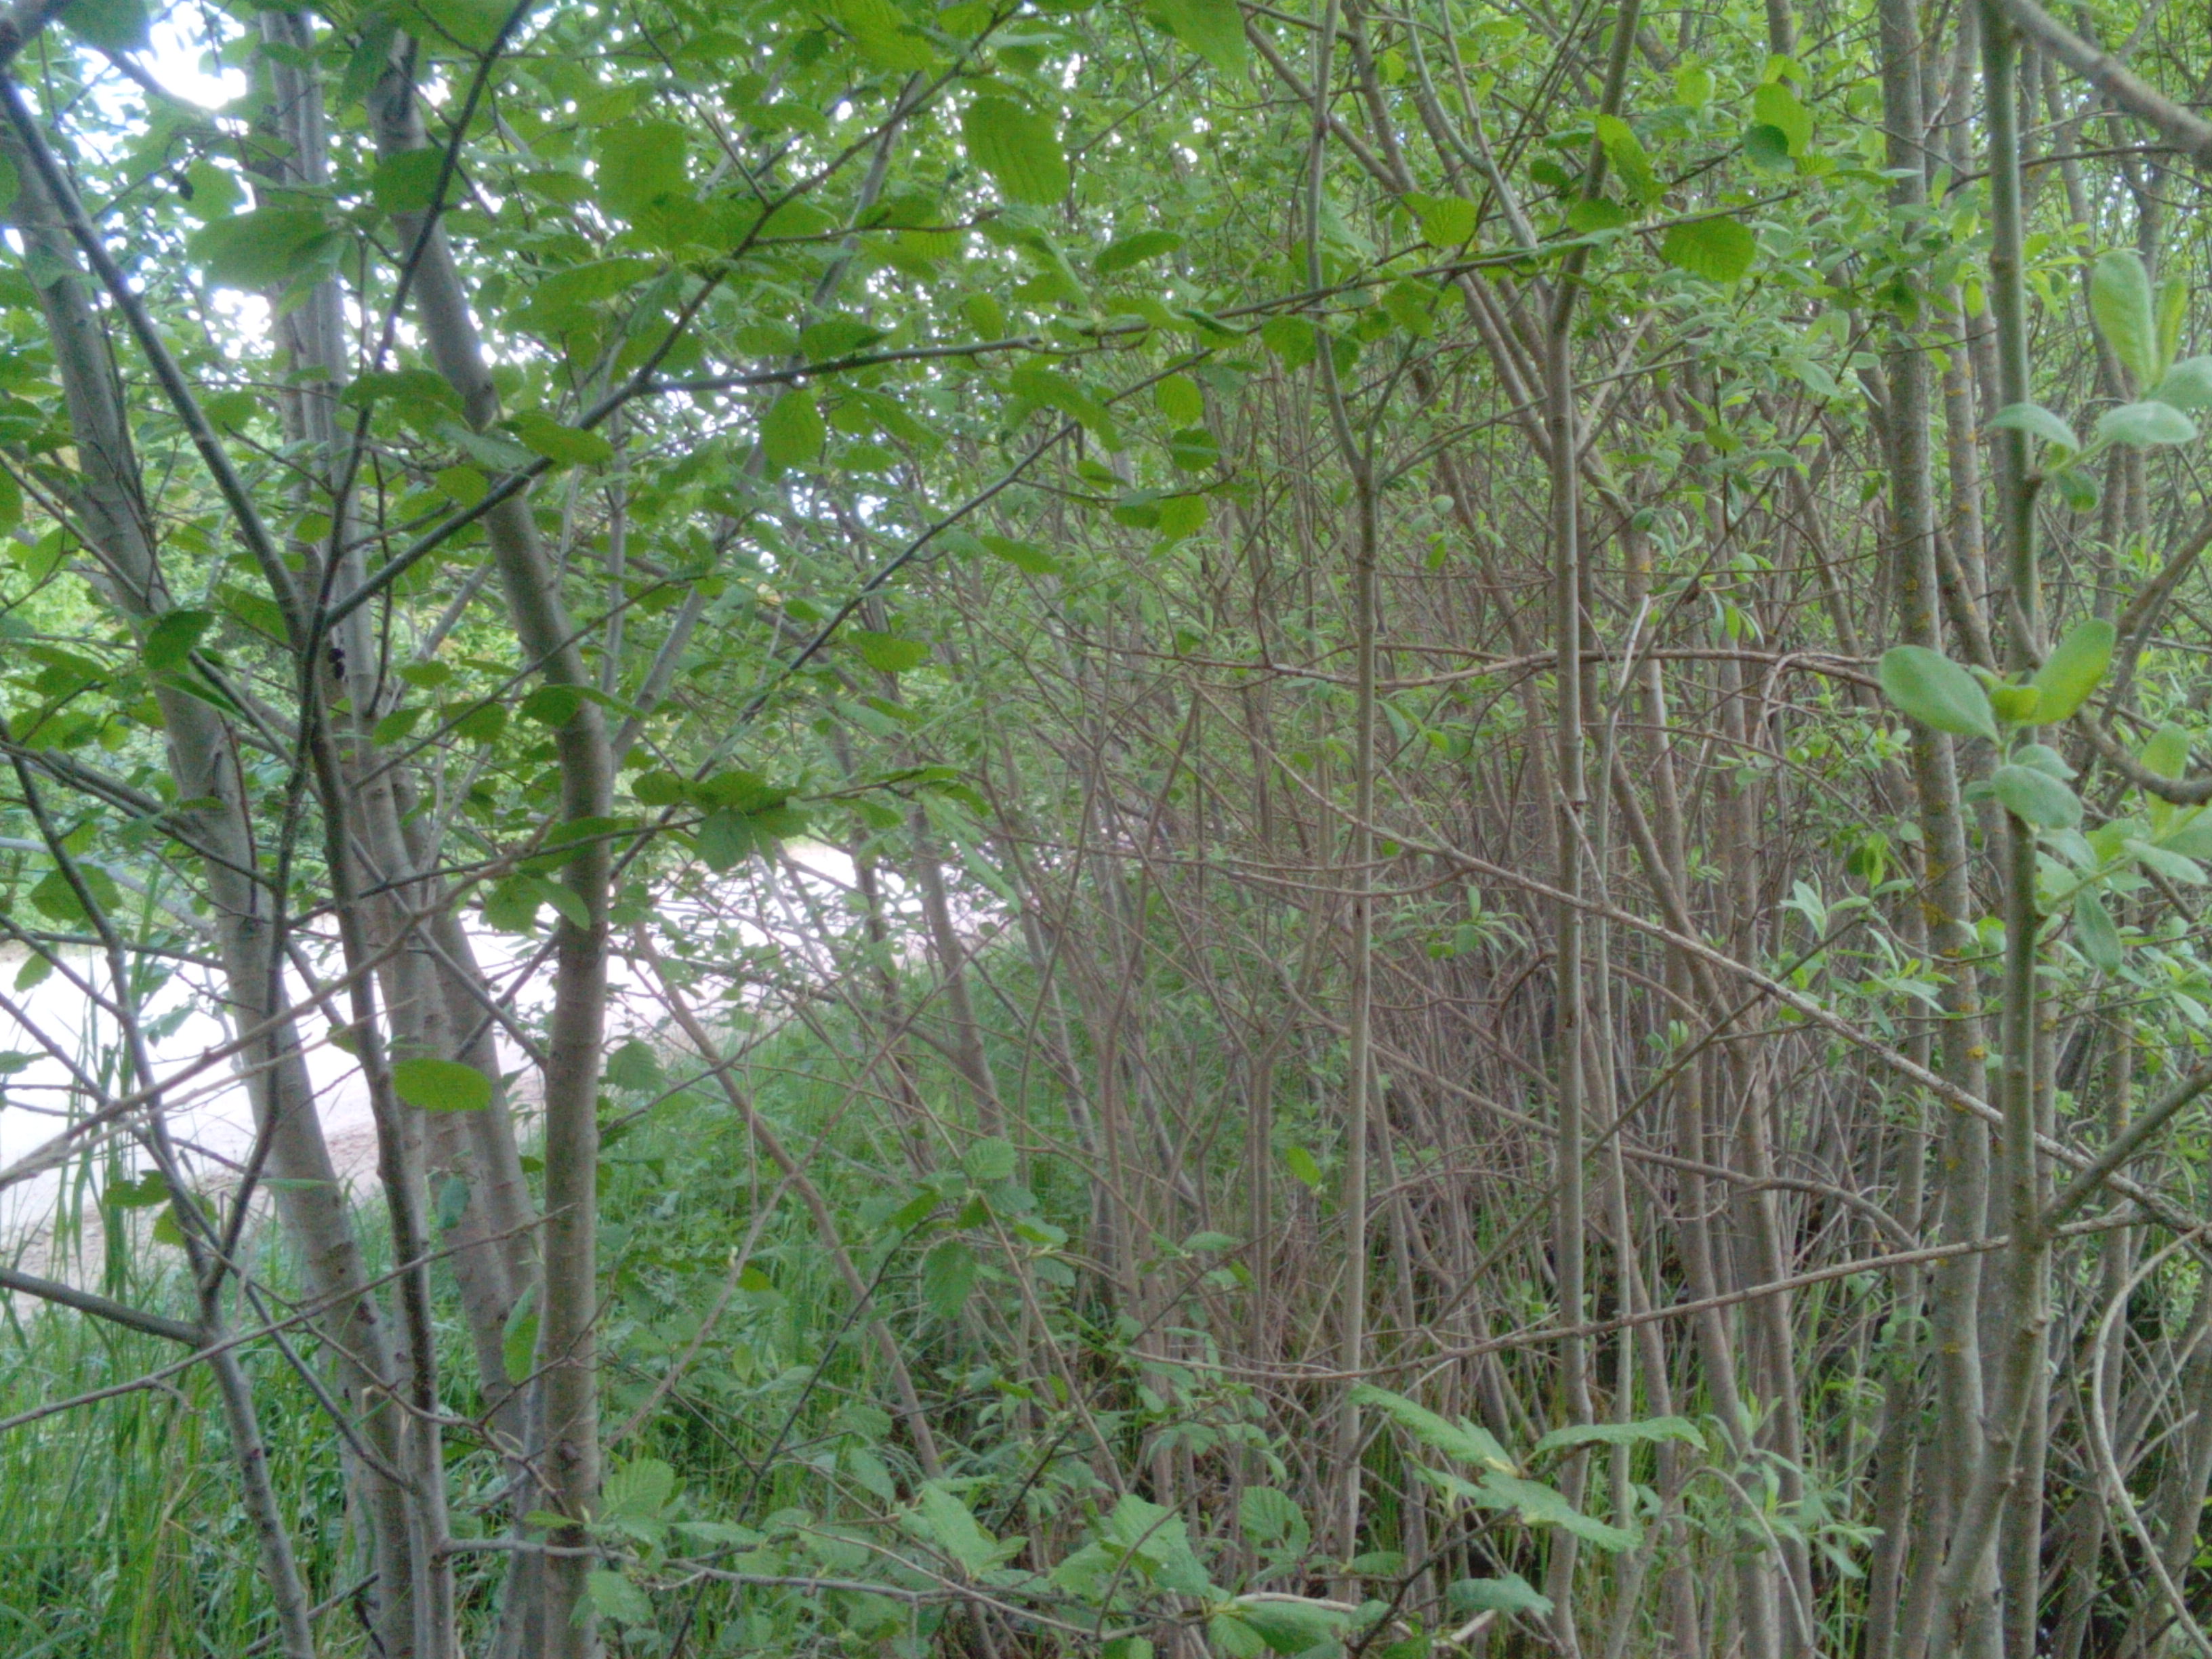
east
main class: Shrubland
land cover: Shrubland without tree cover
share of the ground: > 75 %
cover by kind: shrubs 80 %, herbaceous plants 20 %
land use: Forestry
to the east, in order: Shrubland without tree cover; Paved roads, cycling and walking lanes; Shrubland with sparse tree cover; Spruce dominated mixed woodland
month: May
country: LV
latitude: 56.5196
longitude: 22.3259
